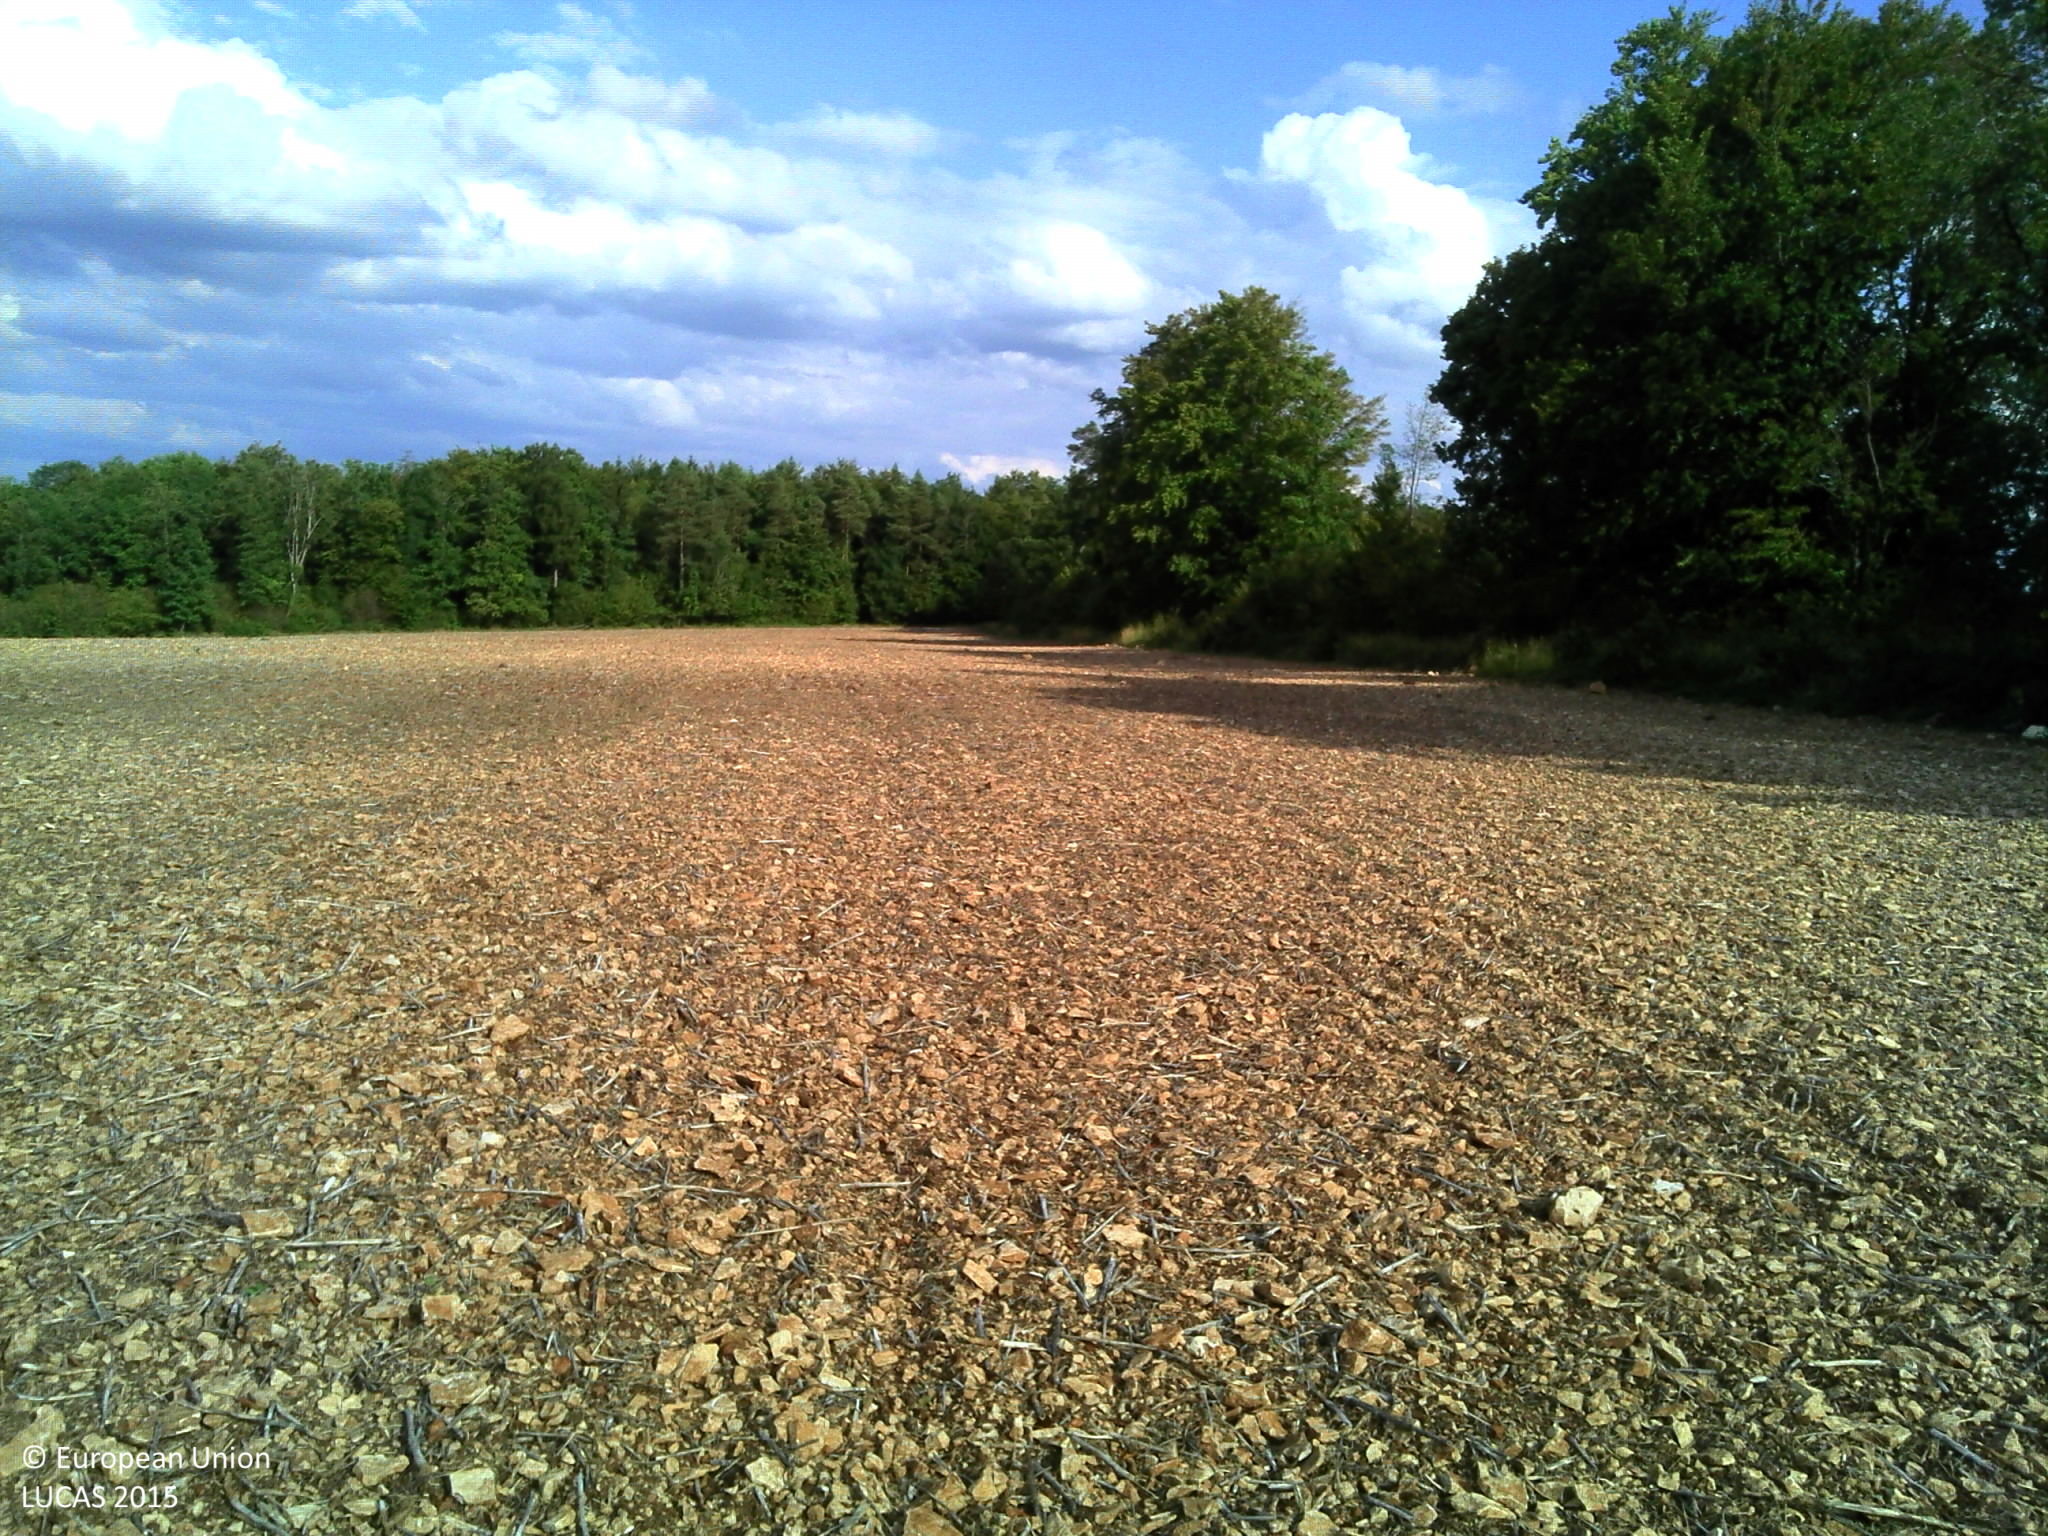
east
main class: Cropland
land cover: Rape and turnip rape
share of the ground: 25 - 50 %
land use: Agriculture (excluding fallow land and kitchen gardens)
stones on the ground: 25 - 50 %
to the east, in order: Rape and turnip rape; Broadleaved woodland
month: September
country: FR
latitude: 47.5600
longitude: 4.8031
